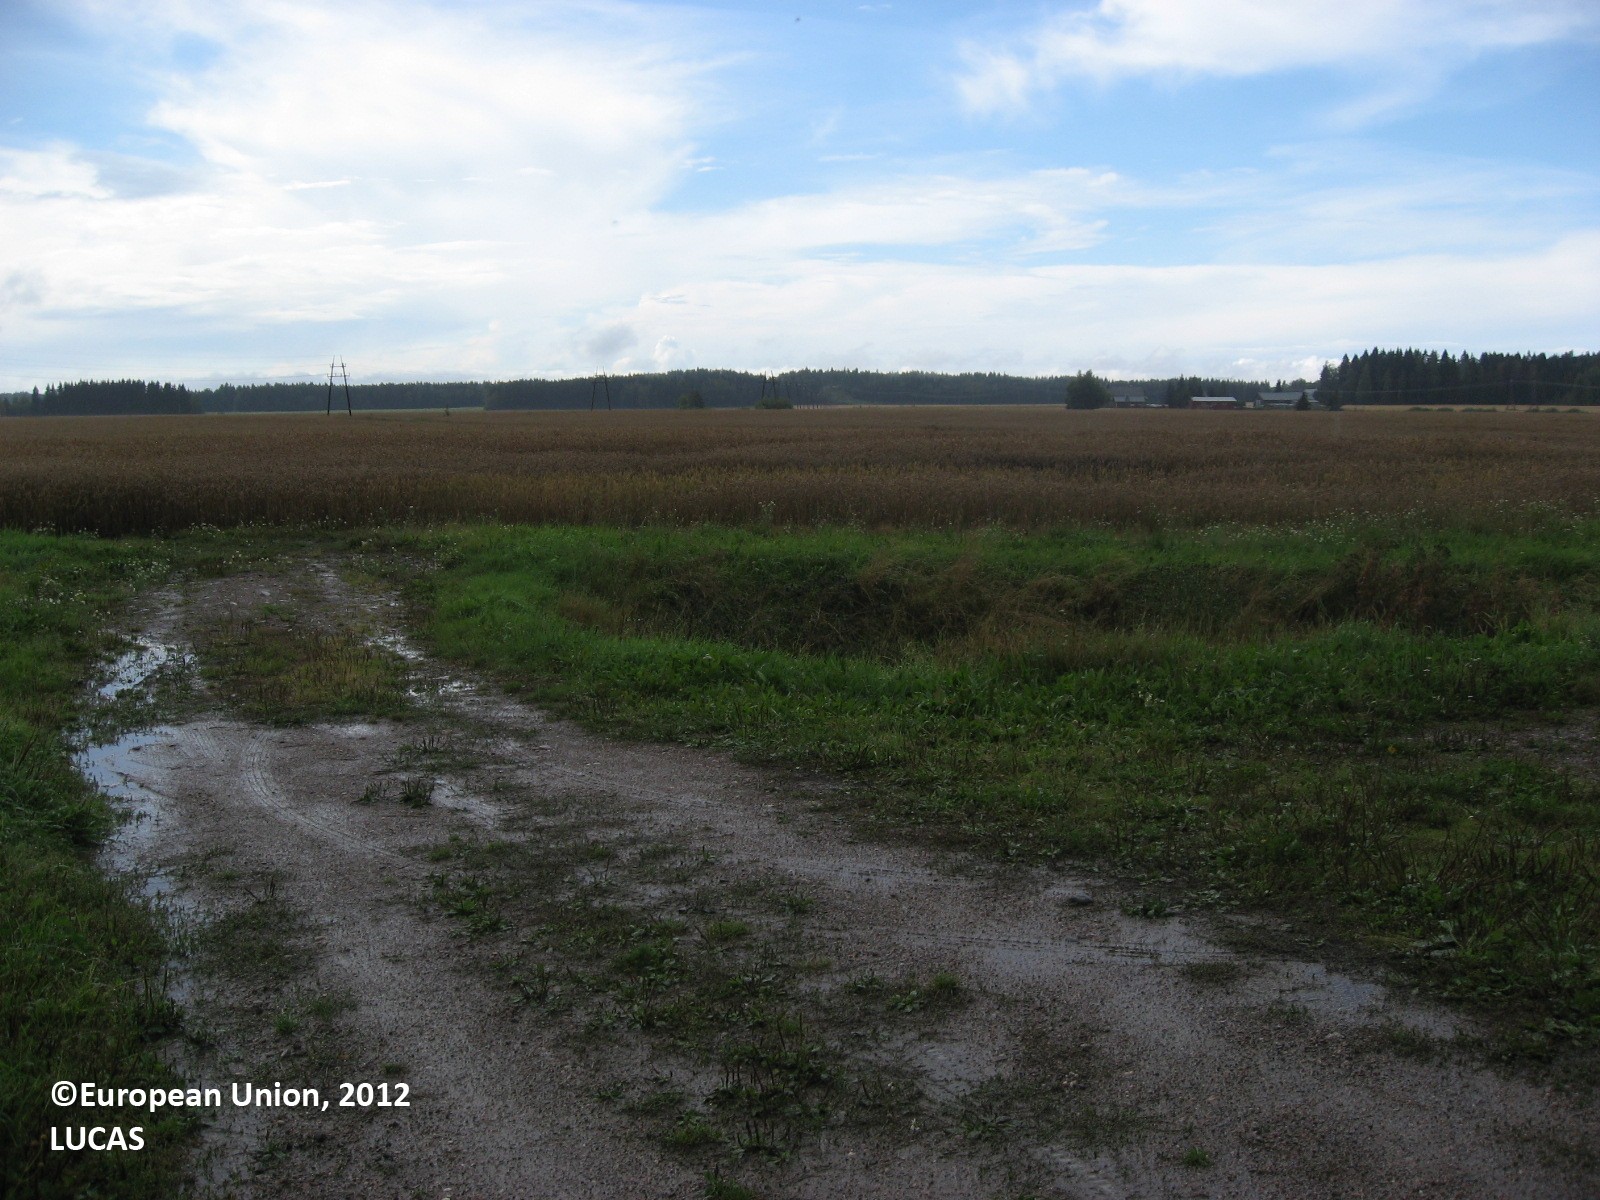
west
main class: Cropland
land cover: Rape and turnip rape
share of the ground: > 75 %
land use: Agriculture (excluding fallow land and kitchen gardens)
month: August
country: FI
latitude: 60.7570
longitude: 25.1107
